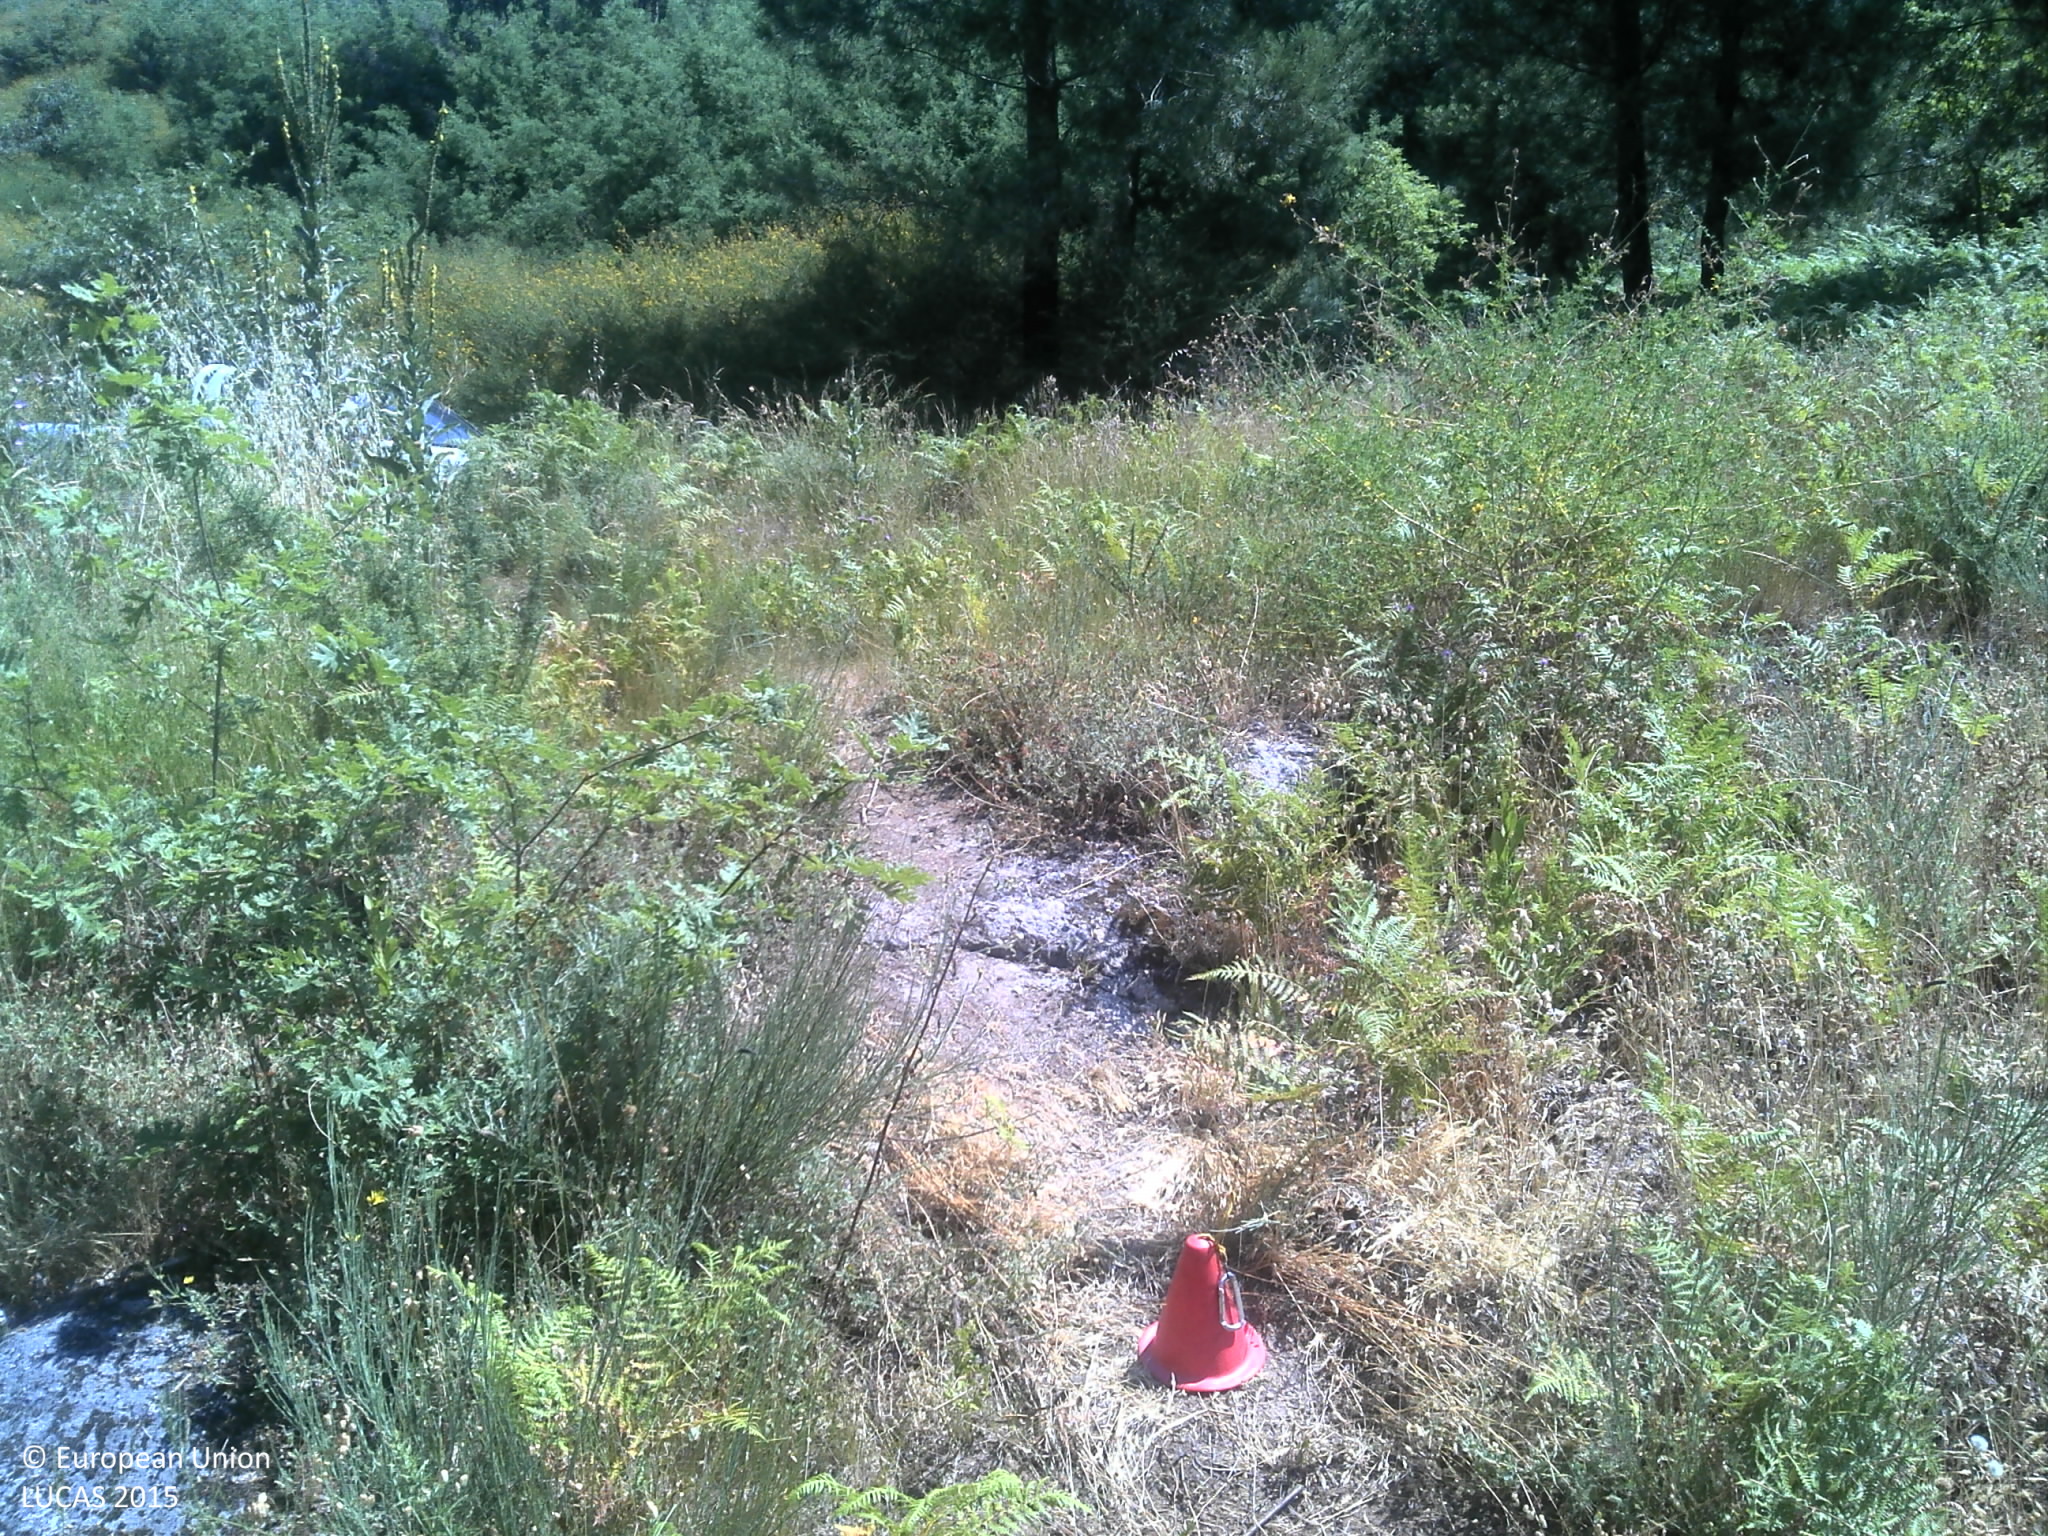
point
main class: Shrubland
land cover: Shrubland with sparse tree cover
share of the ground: 50 - 75 %
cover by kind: shrubs 60 %, herbaceous plants 20 %, consolidated bare surface 10 %, broadleaved forest trees 5 %, unconsolidated bare surface 5 %
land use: Agriculture (excluding fallow land and kitchen gardens)
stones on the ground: 25 - 50 %
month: June
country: PT
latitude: 41.1638
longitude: -7.9514
